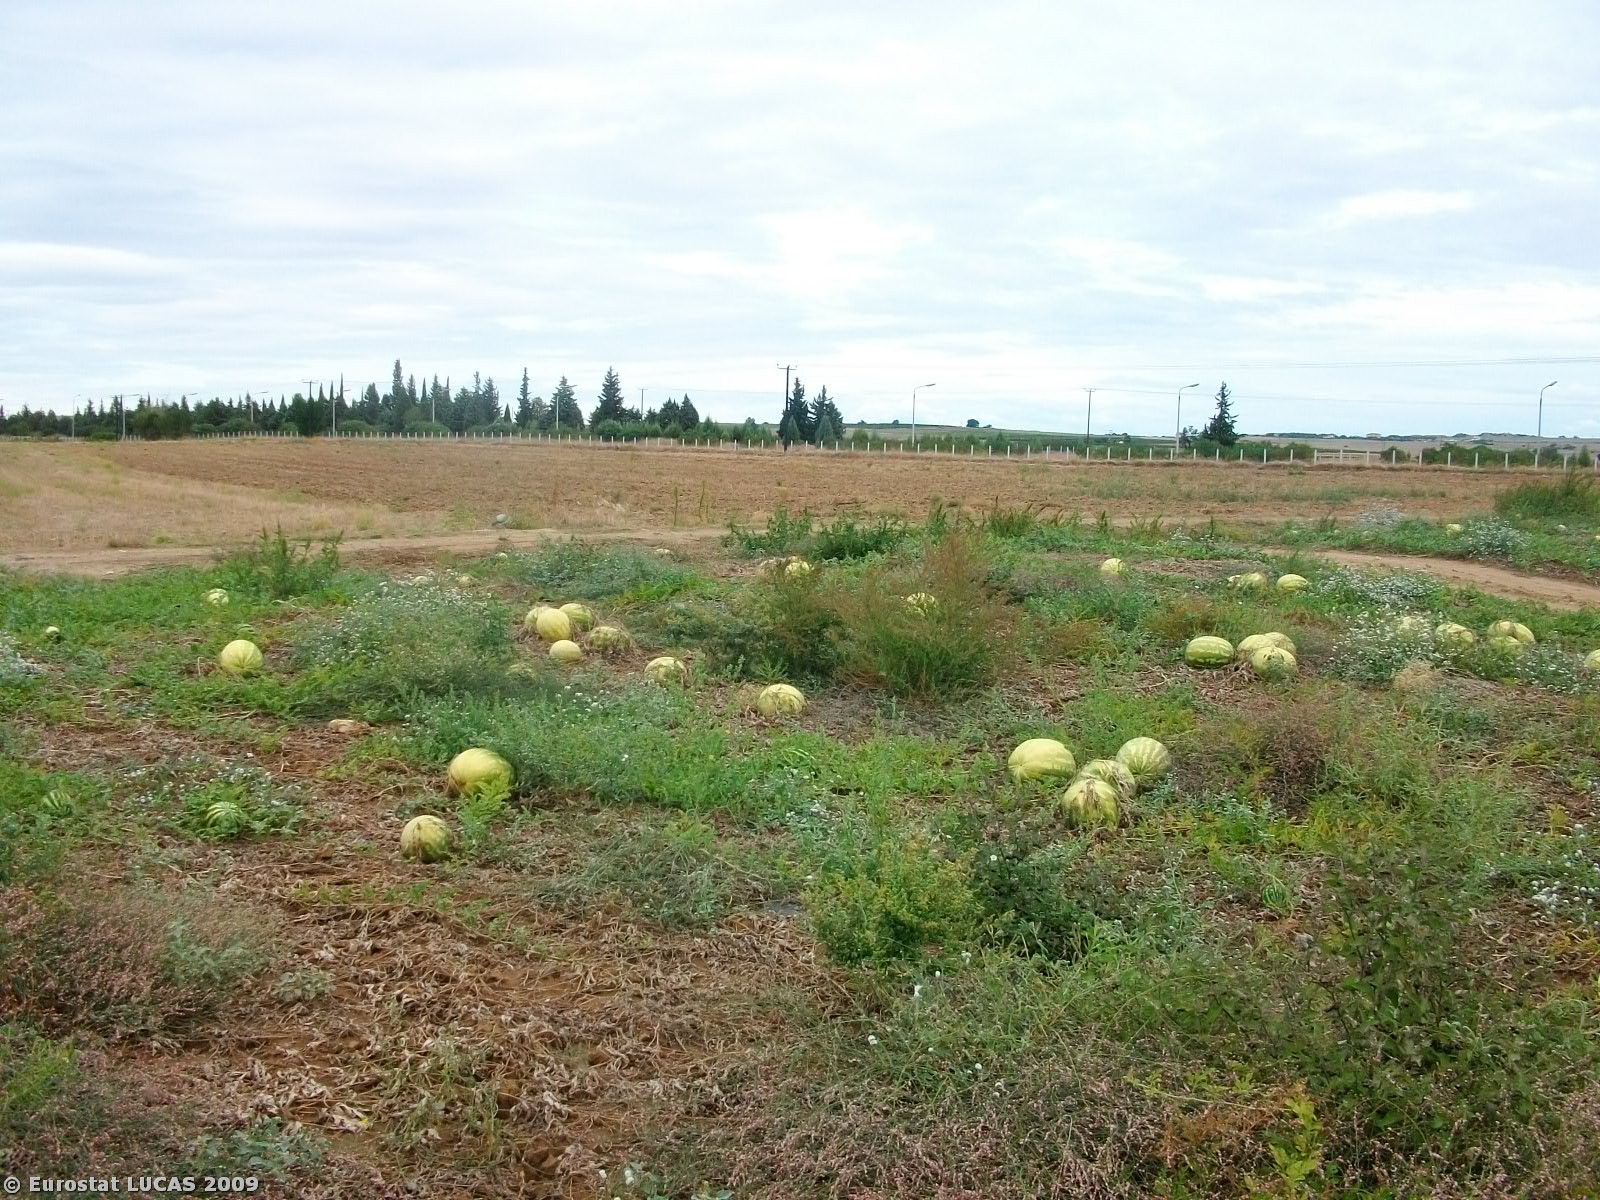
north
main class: Cropland
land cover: Other fresh vegetables
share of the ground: > 75 %
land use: Agriculture (excluding fallow land and kitchen gardens)
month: September
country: GR
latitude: 40.7738
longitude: 22.6952
